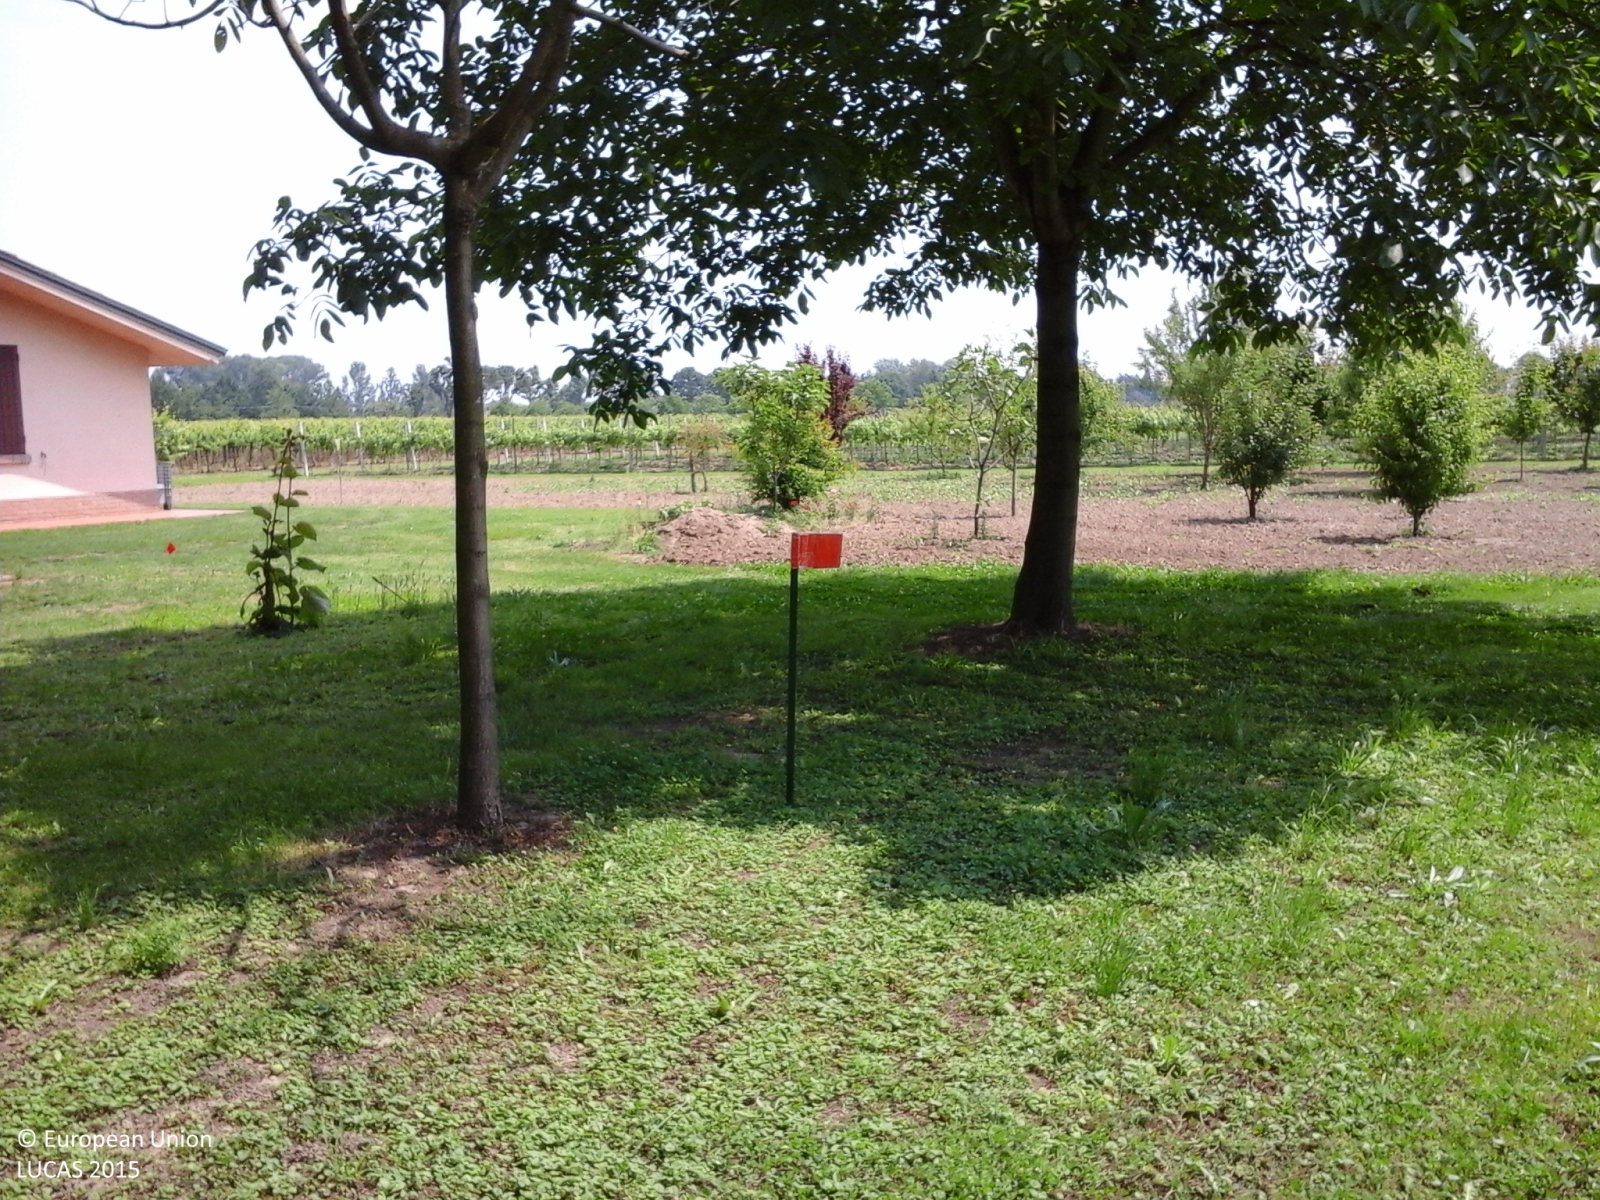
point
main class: Woodland
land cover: Broadleaved woodland
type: thermophilous deciduous forest
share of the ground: 50 - 75 %
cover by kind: herbaceous plants 85 %, broadleaved forest trees 15 %
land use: Residential
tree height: > 5 m
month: May
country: IT
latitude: 44.7803
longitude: 10.7945
